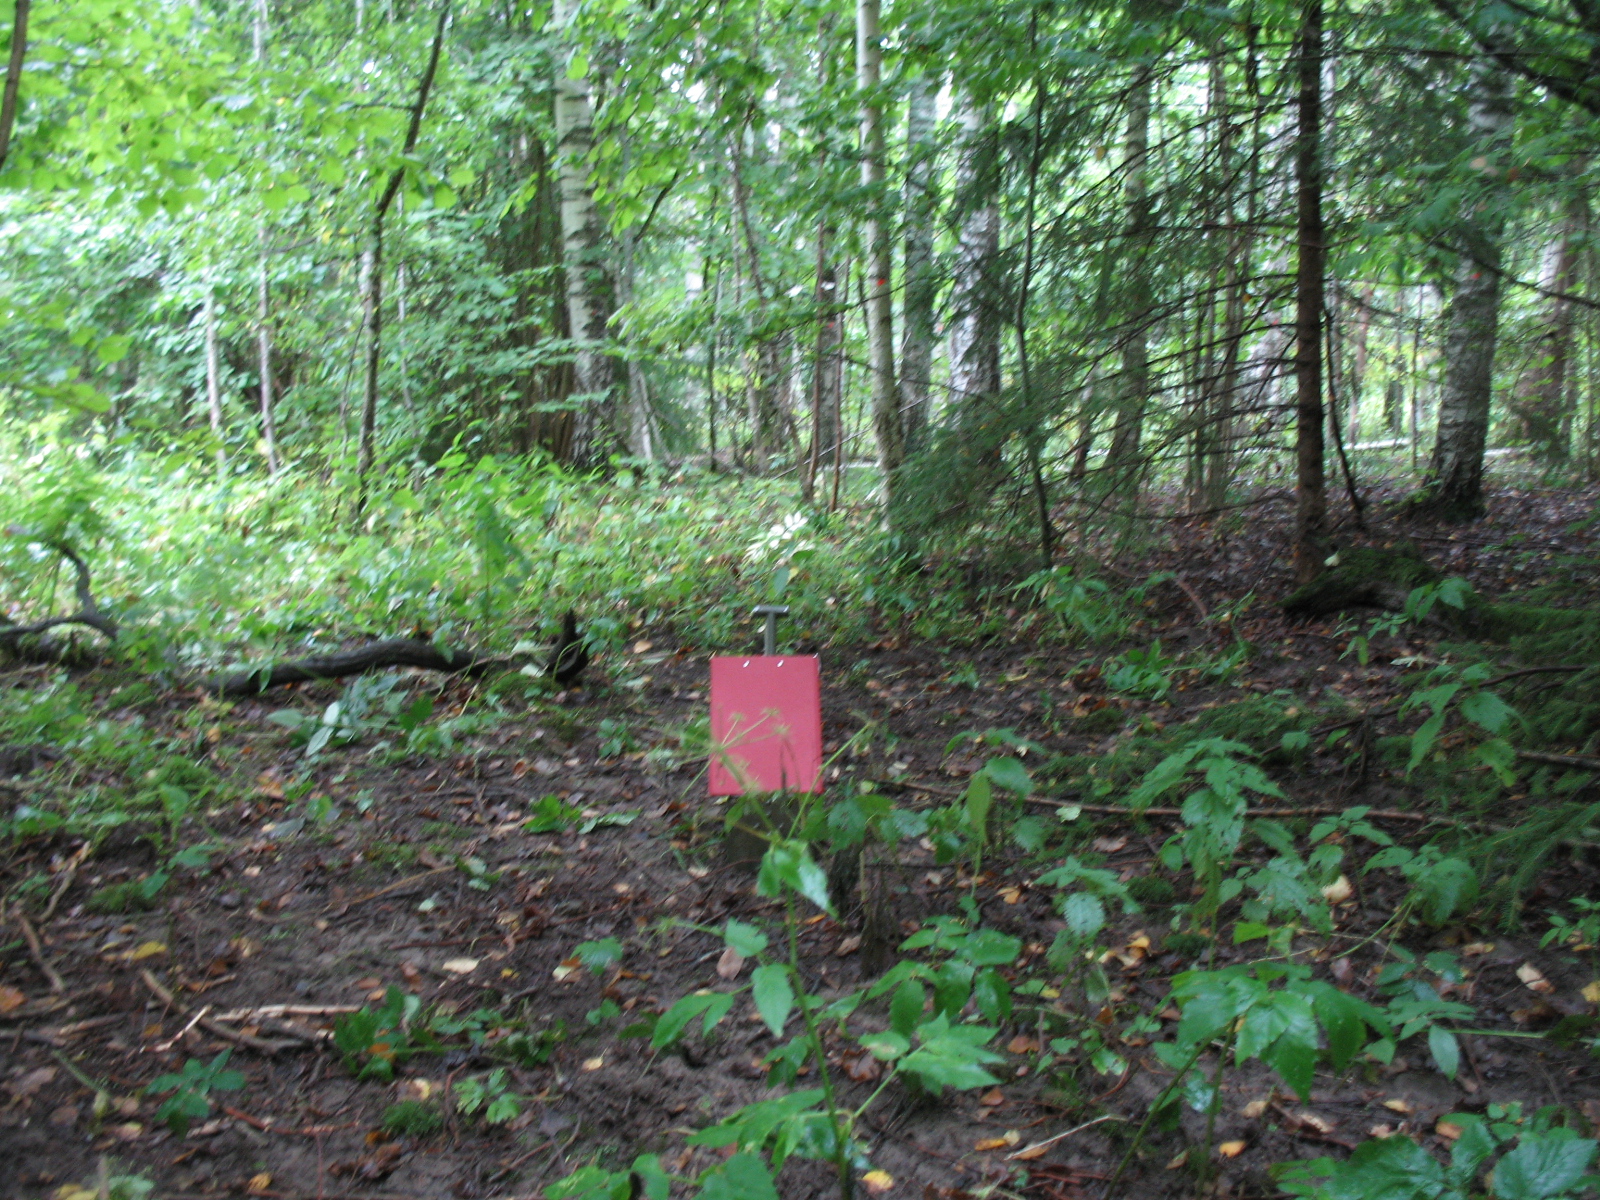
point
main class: Woodland
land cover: Broadleaved woodland
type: non-riverine alder, birch or aspen forest
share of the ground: > 75 %
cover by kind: broadleaved forest trees 80 %, herbaceous plants 15 %, coniferous forest trees 5 %
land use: Forestry
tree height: > 5 m
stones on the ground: < 10 %
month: September
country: LV
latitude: 56.1801
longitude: 26.0364
